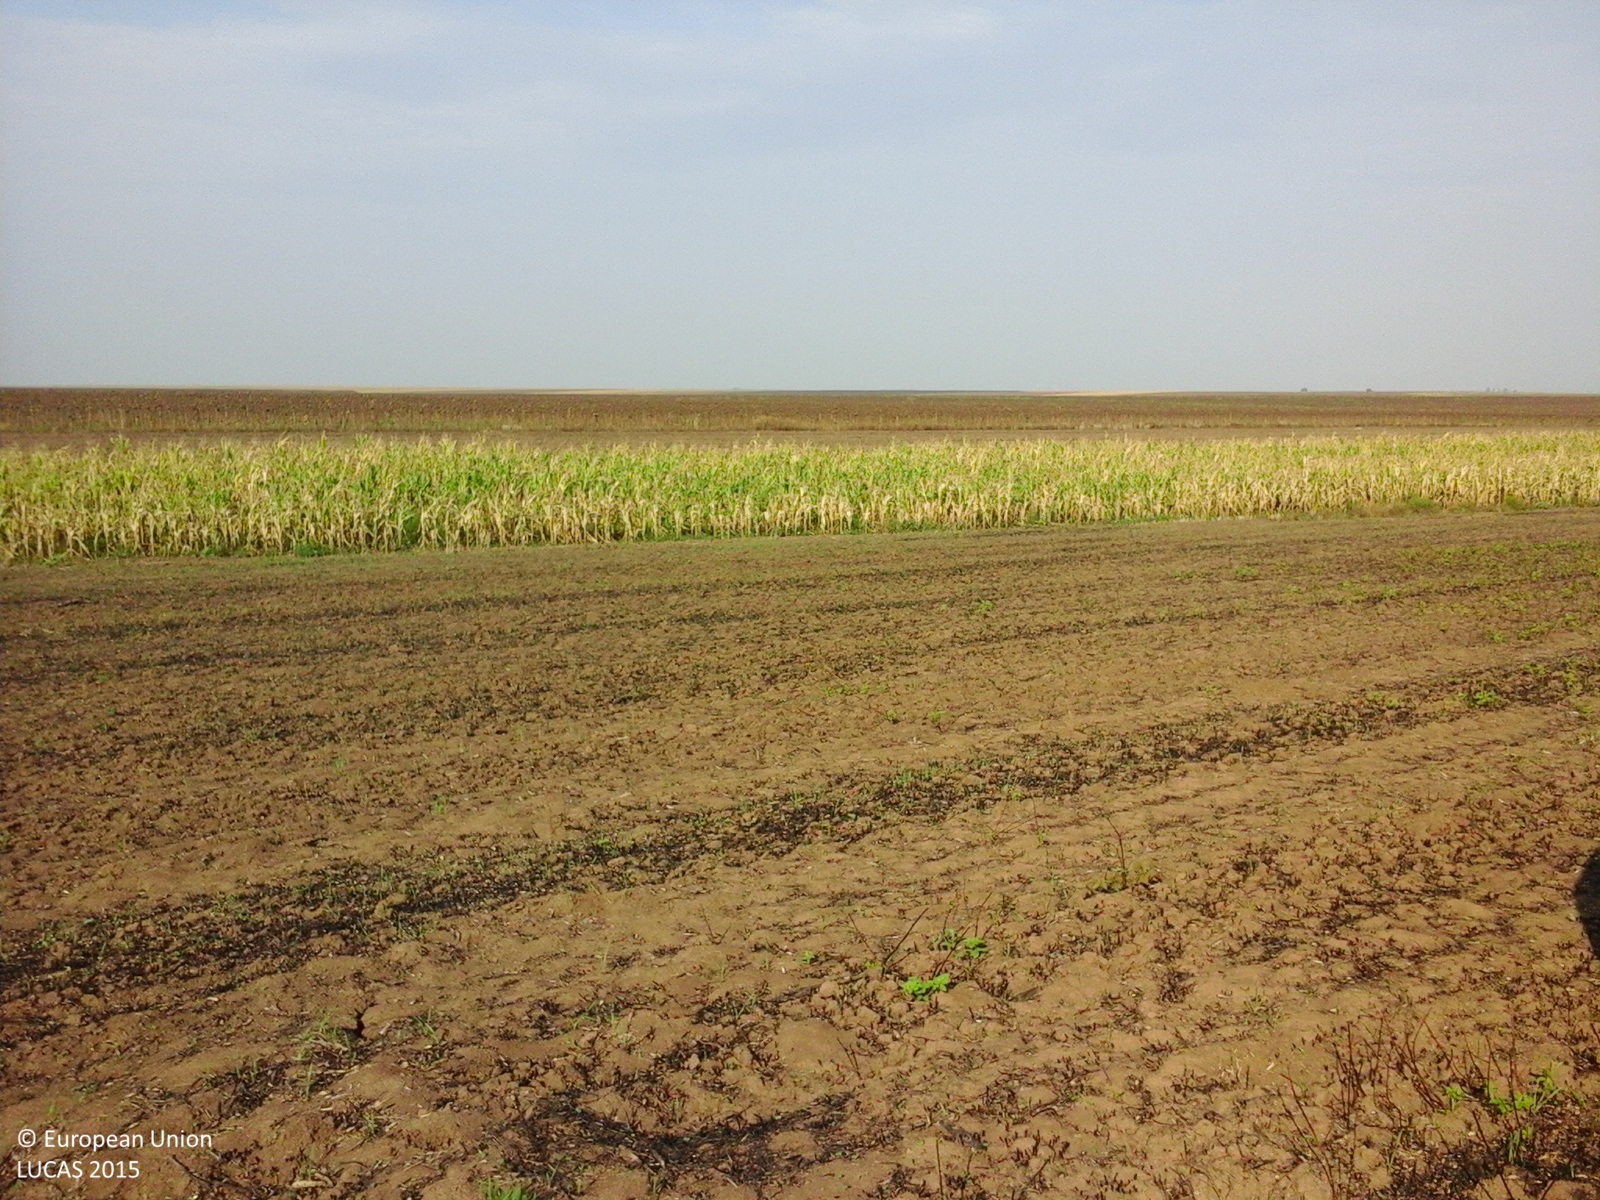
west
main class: Cropland
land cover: Sunflower
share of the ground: > 75 %
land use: Agriculture (excluding fallow land and kitchen gardens)
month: August
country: RO
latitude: 46.0766
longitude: 21.4786
